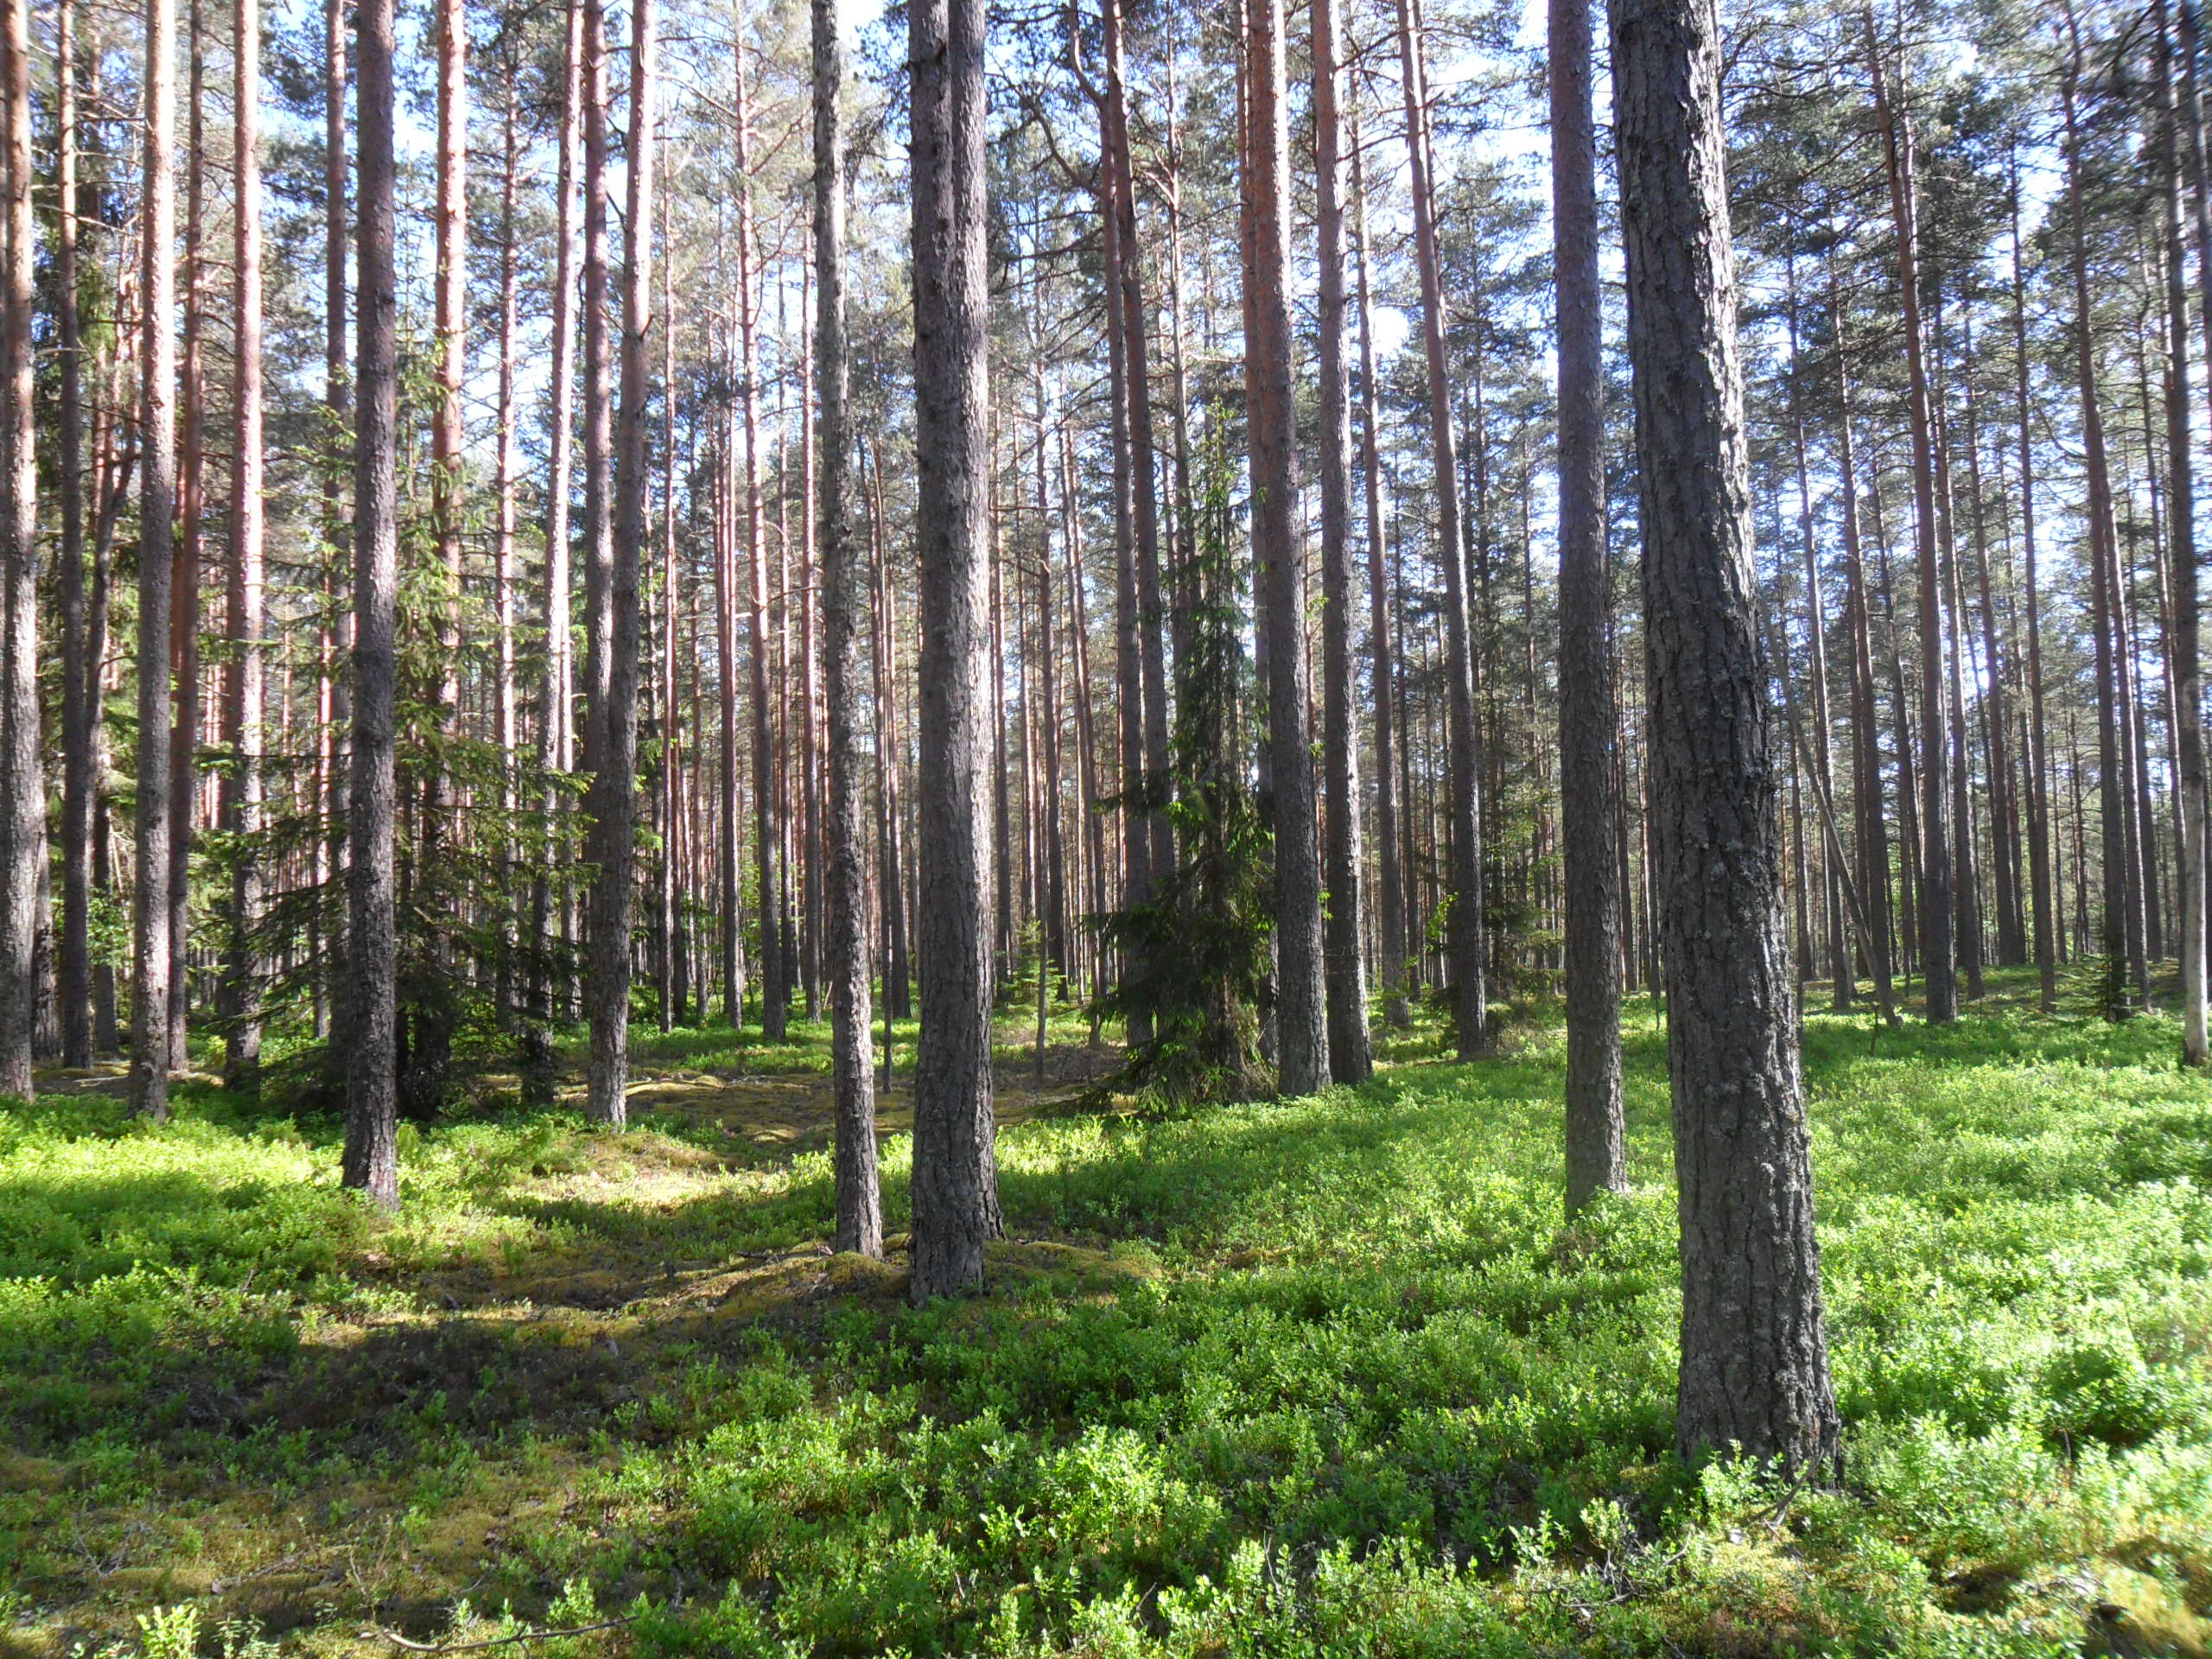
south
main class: Woodland
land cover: Pine dominated coniferous woodland
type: hemiboreal forest and nemoral coniferous forest and mixed broadleaved-coniferous forest
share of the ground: > 75 %
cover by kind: coniferous forest trees 90 %, herbaceous plants 10 %
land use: Forestry
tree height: > 5 m
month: June
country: LV
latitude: 57.5667
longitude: 22.2355
